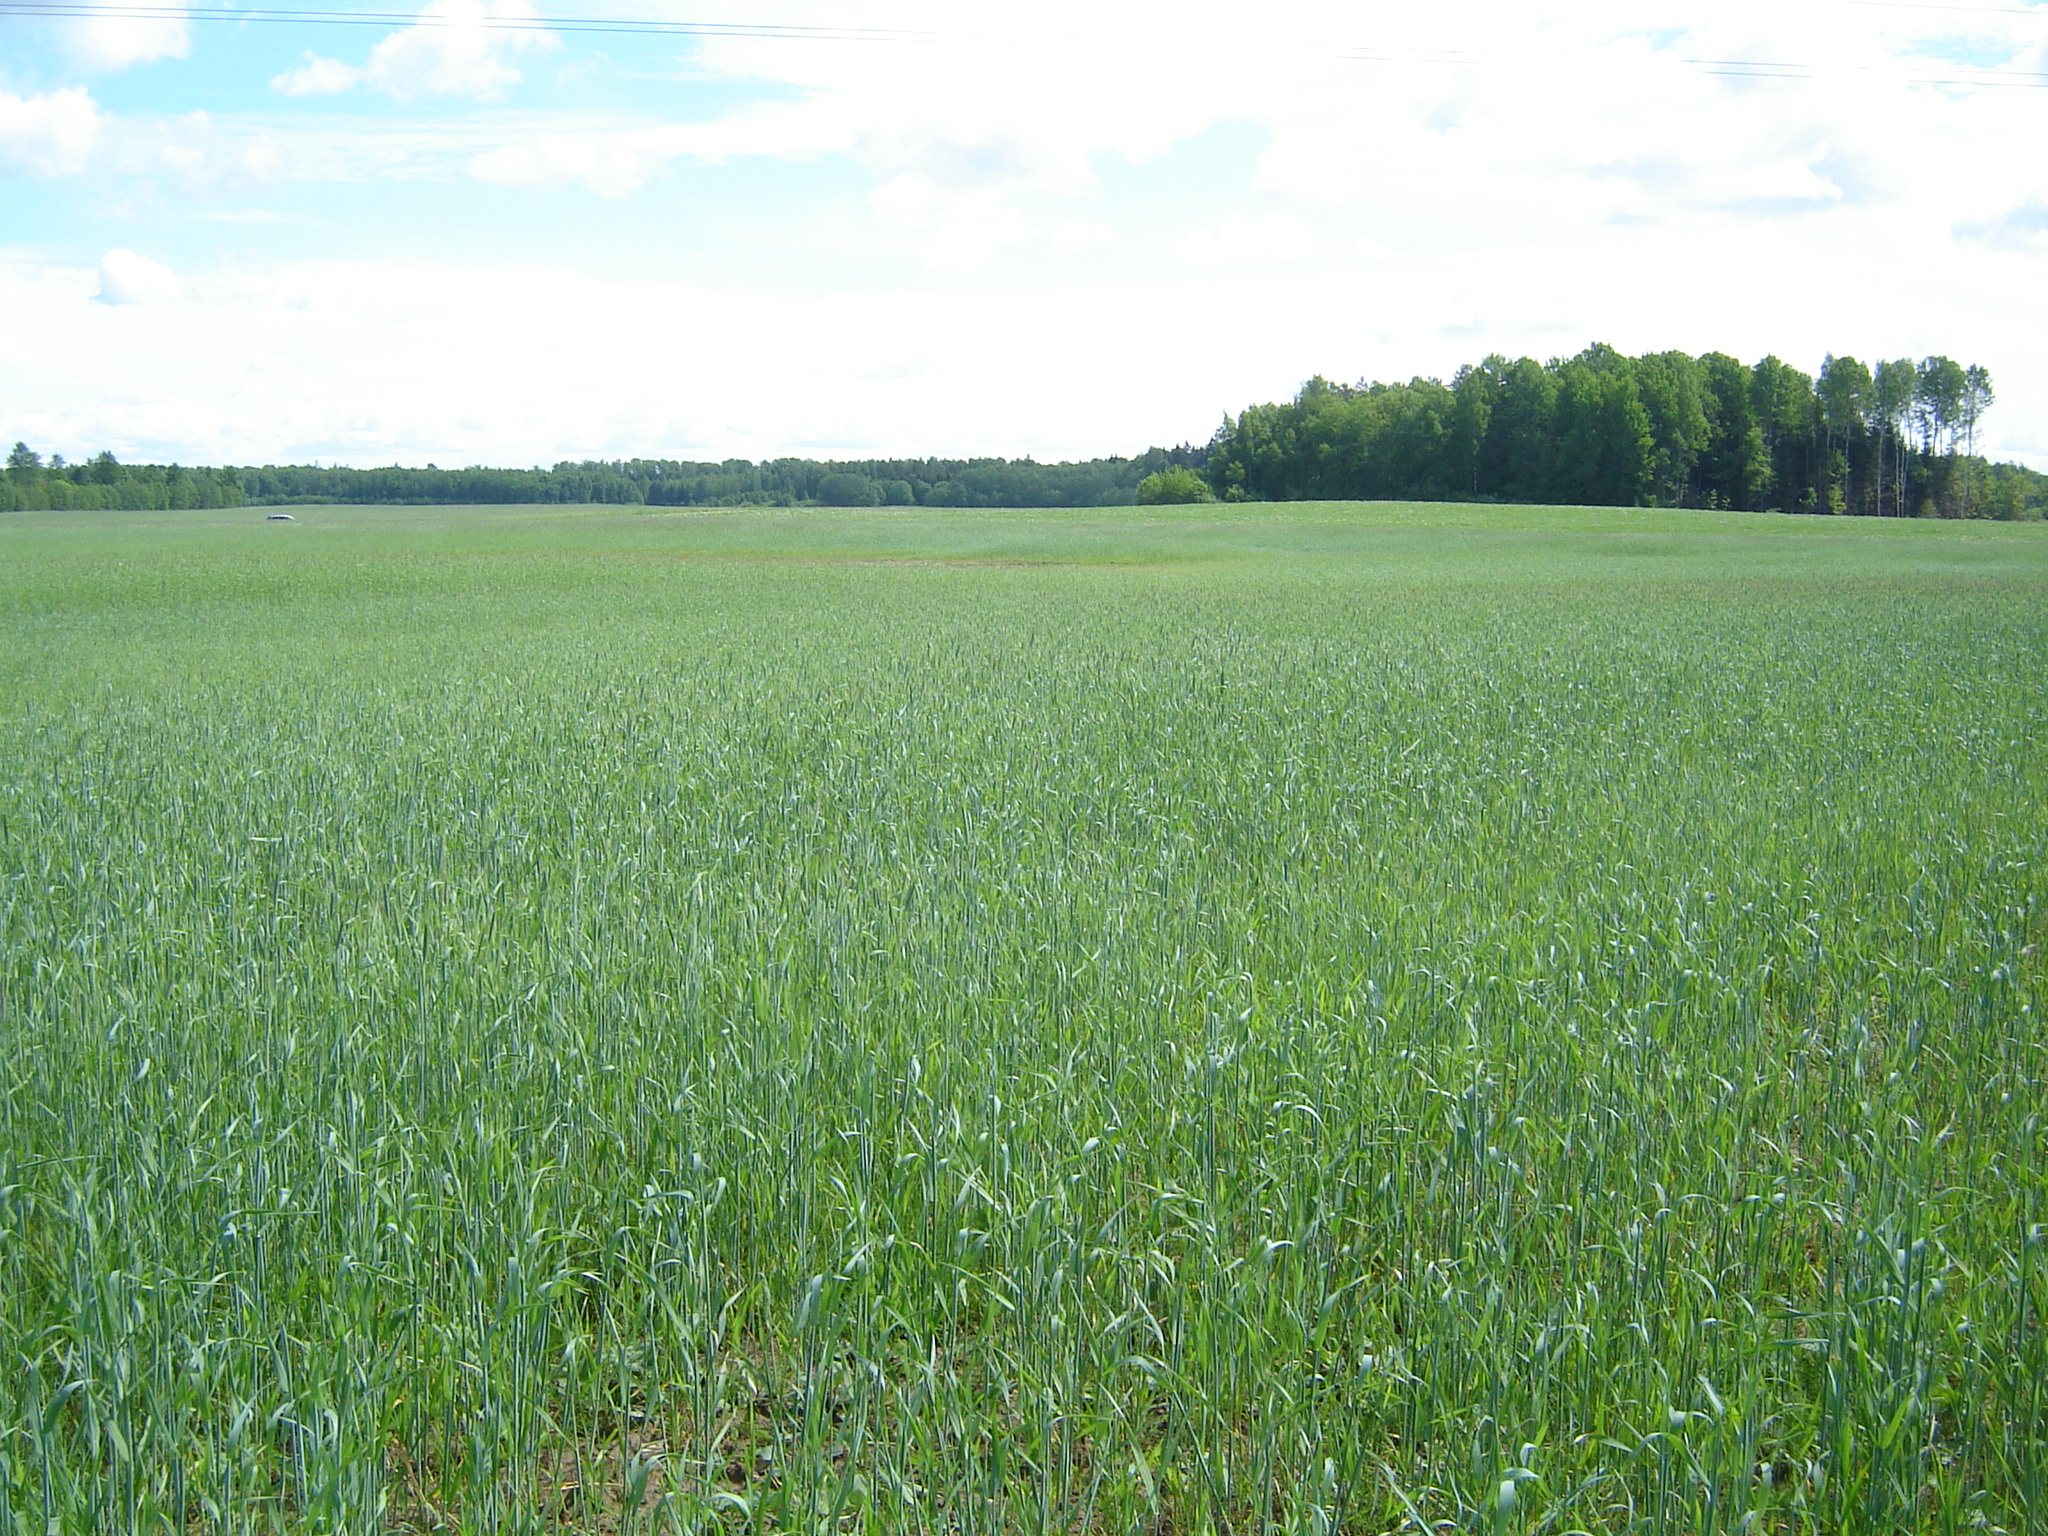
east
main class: Cropland
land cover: Rye
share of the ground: > 75 %
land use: Agriculture (excluding fallow land and kitchen gardens)
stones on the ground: < 10 %
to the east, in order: Rye; Electric lines; Rye; Grassland without tree/shrub cover; Abandoned hedges; Ditches and canals; Abandoned hedges; Grassland without tree/shrub cover
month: May
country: LT
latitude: 55.7933
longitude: 25.1550
